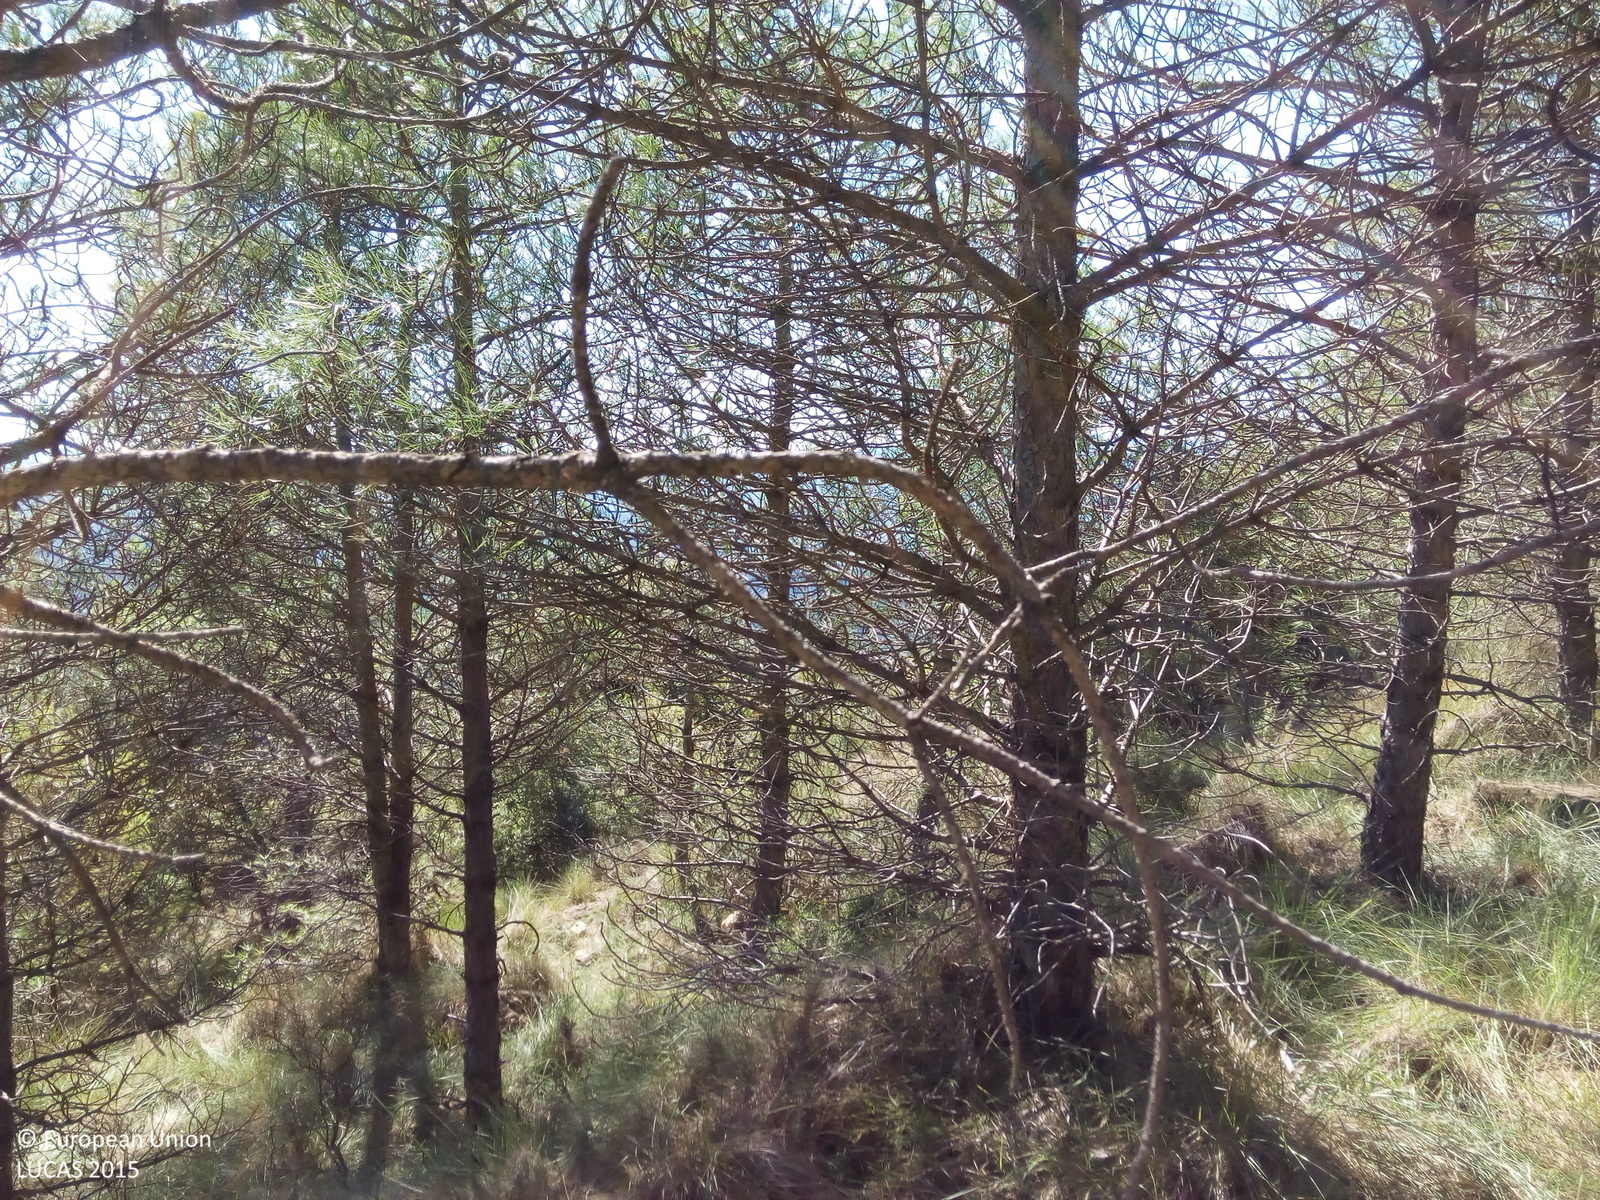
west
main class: Woodland
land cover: Pine dominated coniferous woodland
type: alpine coniferous forest
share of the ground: > 75 %
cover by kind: coniferous forest trees 80 %, shrubs 20 %
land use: Forestry
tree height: > 5 m
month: August
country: ES
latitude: 42.4316
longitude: 0.1940
